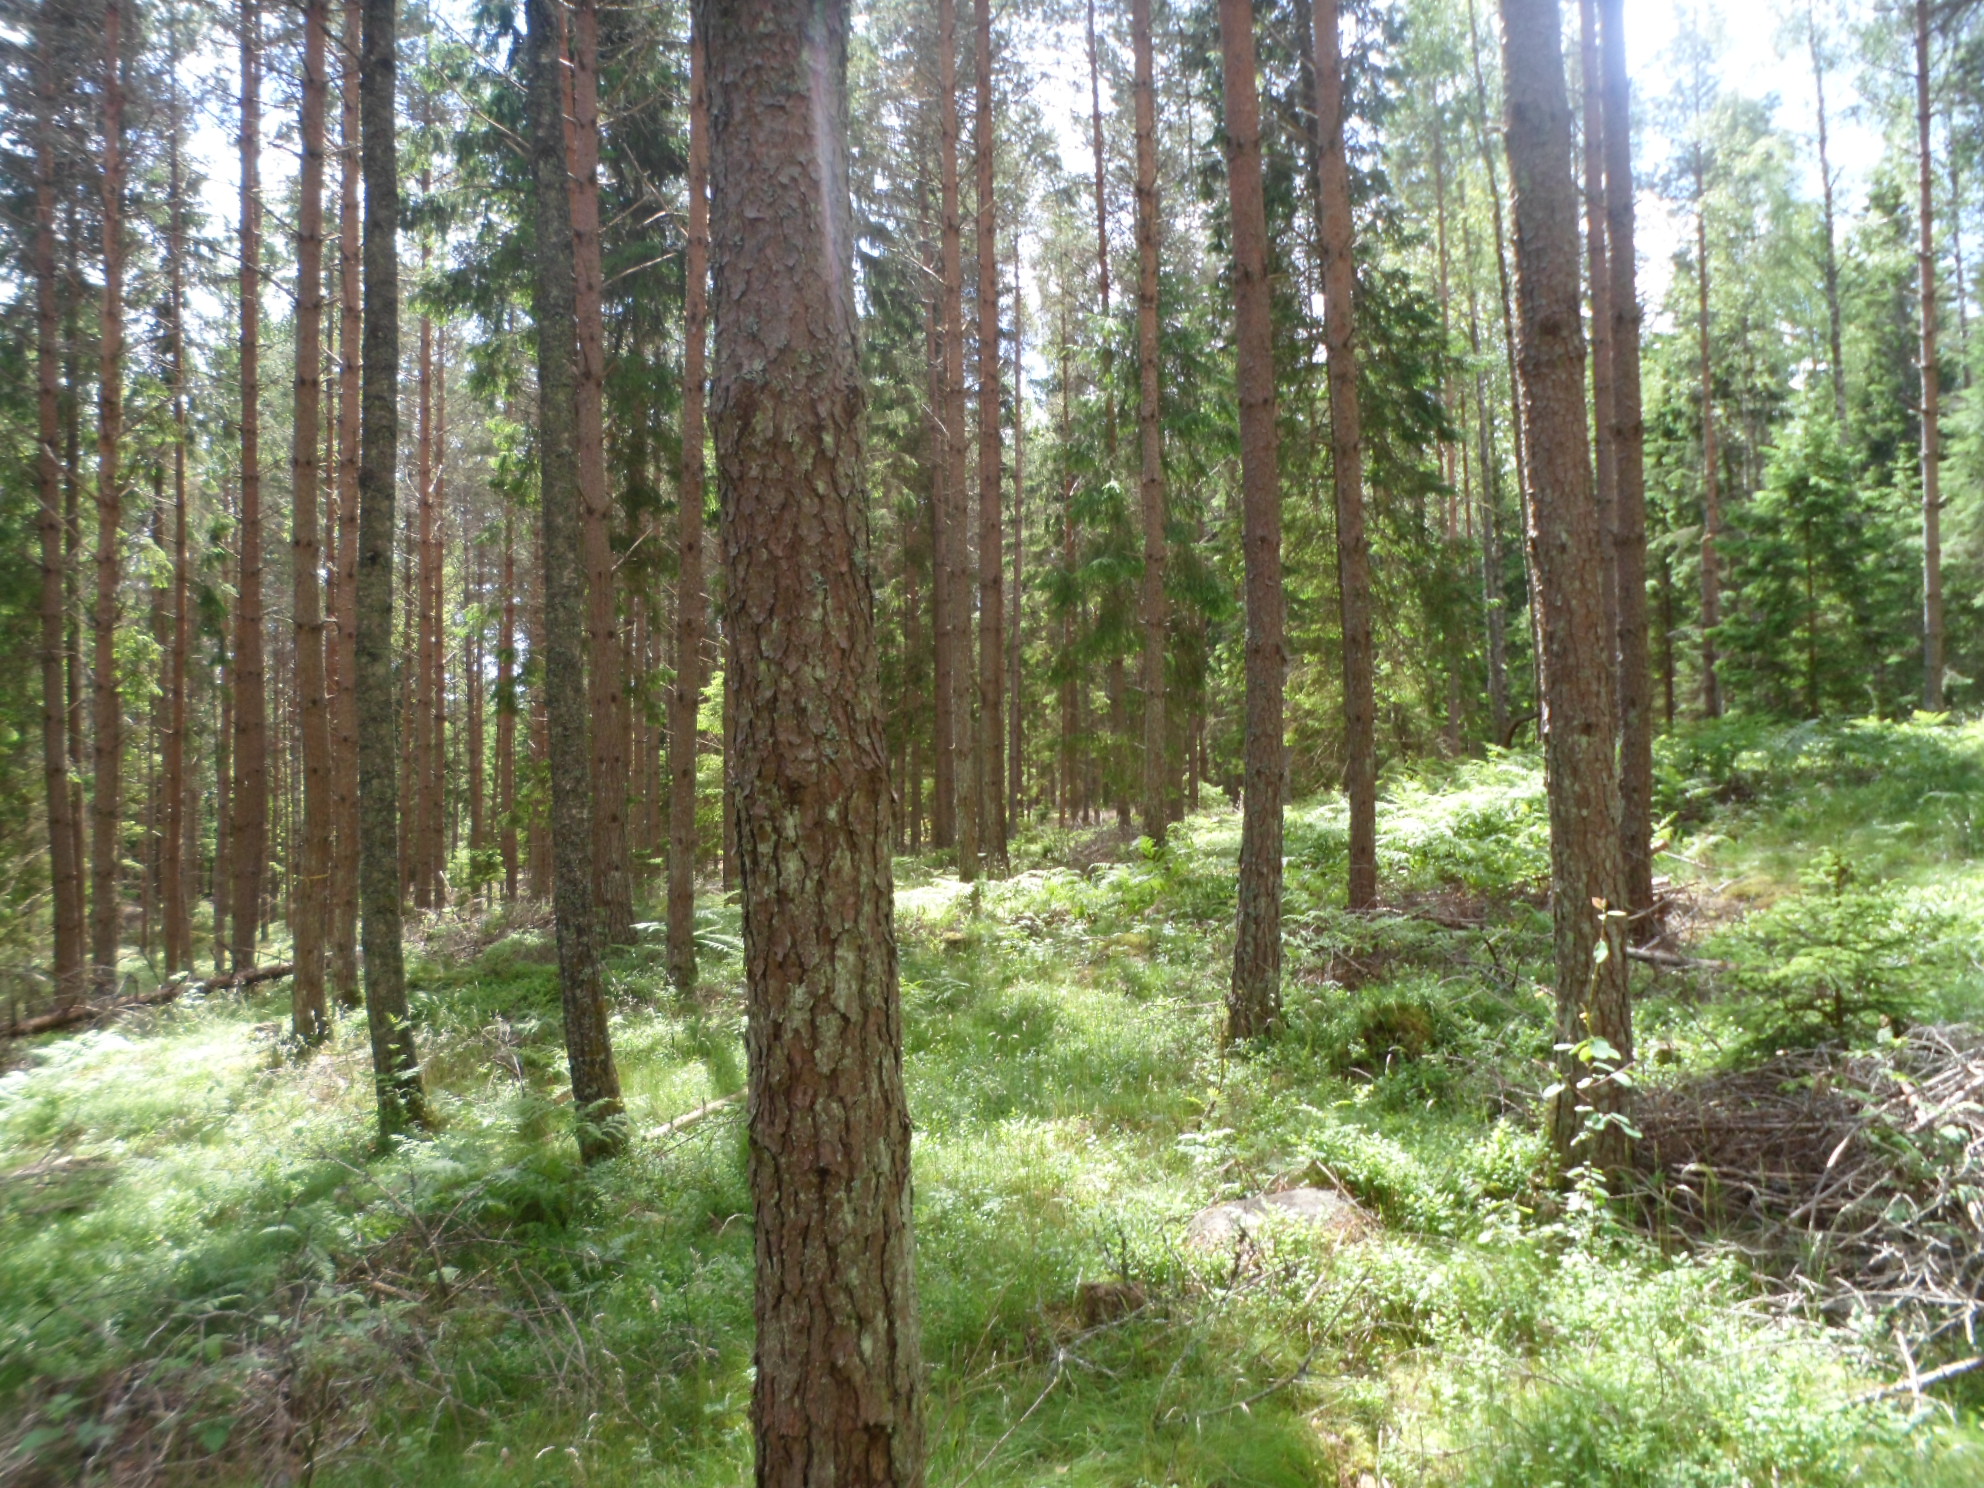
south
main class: Woodland
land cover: Pine dominated coniferous woodland
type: boreal forest
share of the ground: 50 - 75 %
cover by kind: coniferous forest trees 60 %, shrubs 20 %, lichens and mosses 15 %, herbaceous plants 5 %
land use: Forestry
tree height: > 5 m
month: June
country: SE
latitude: 57.1056
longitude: 14.8340
